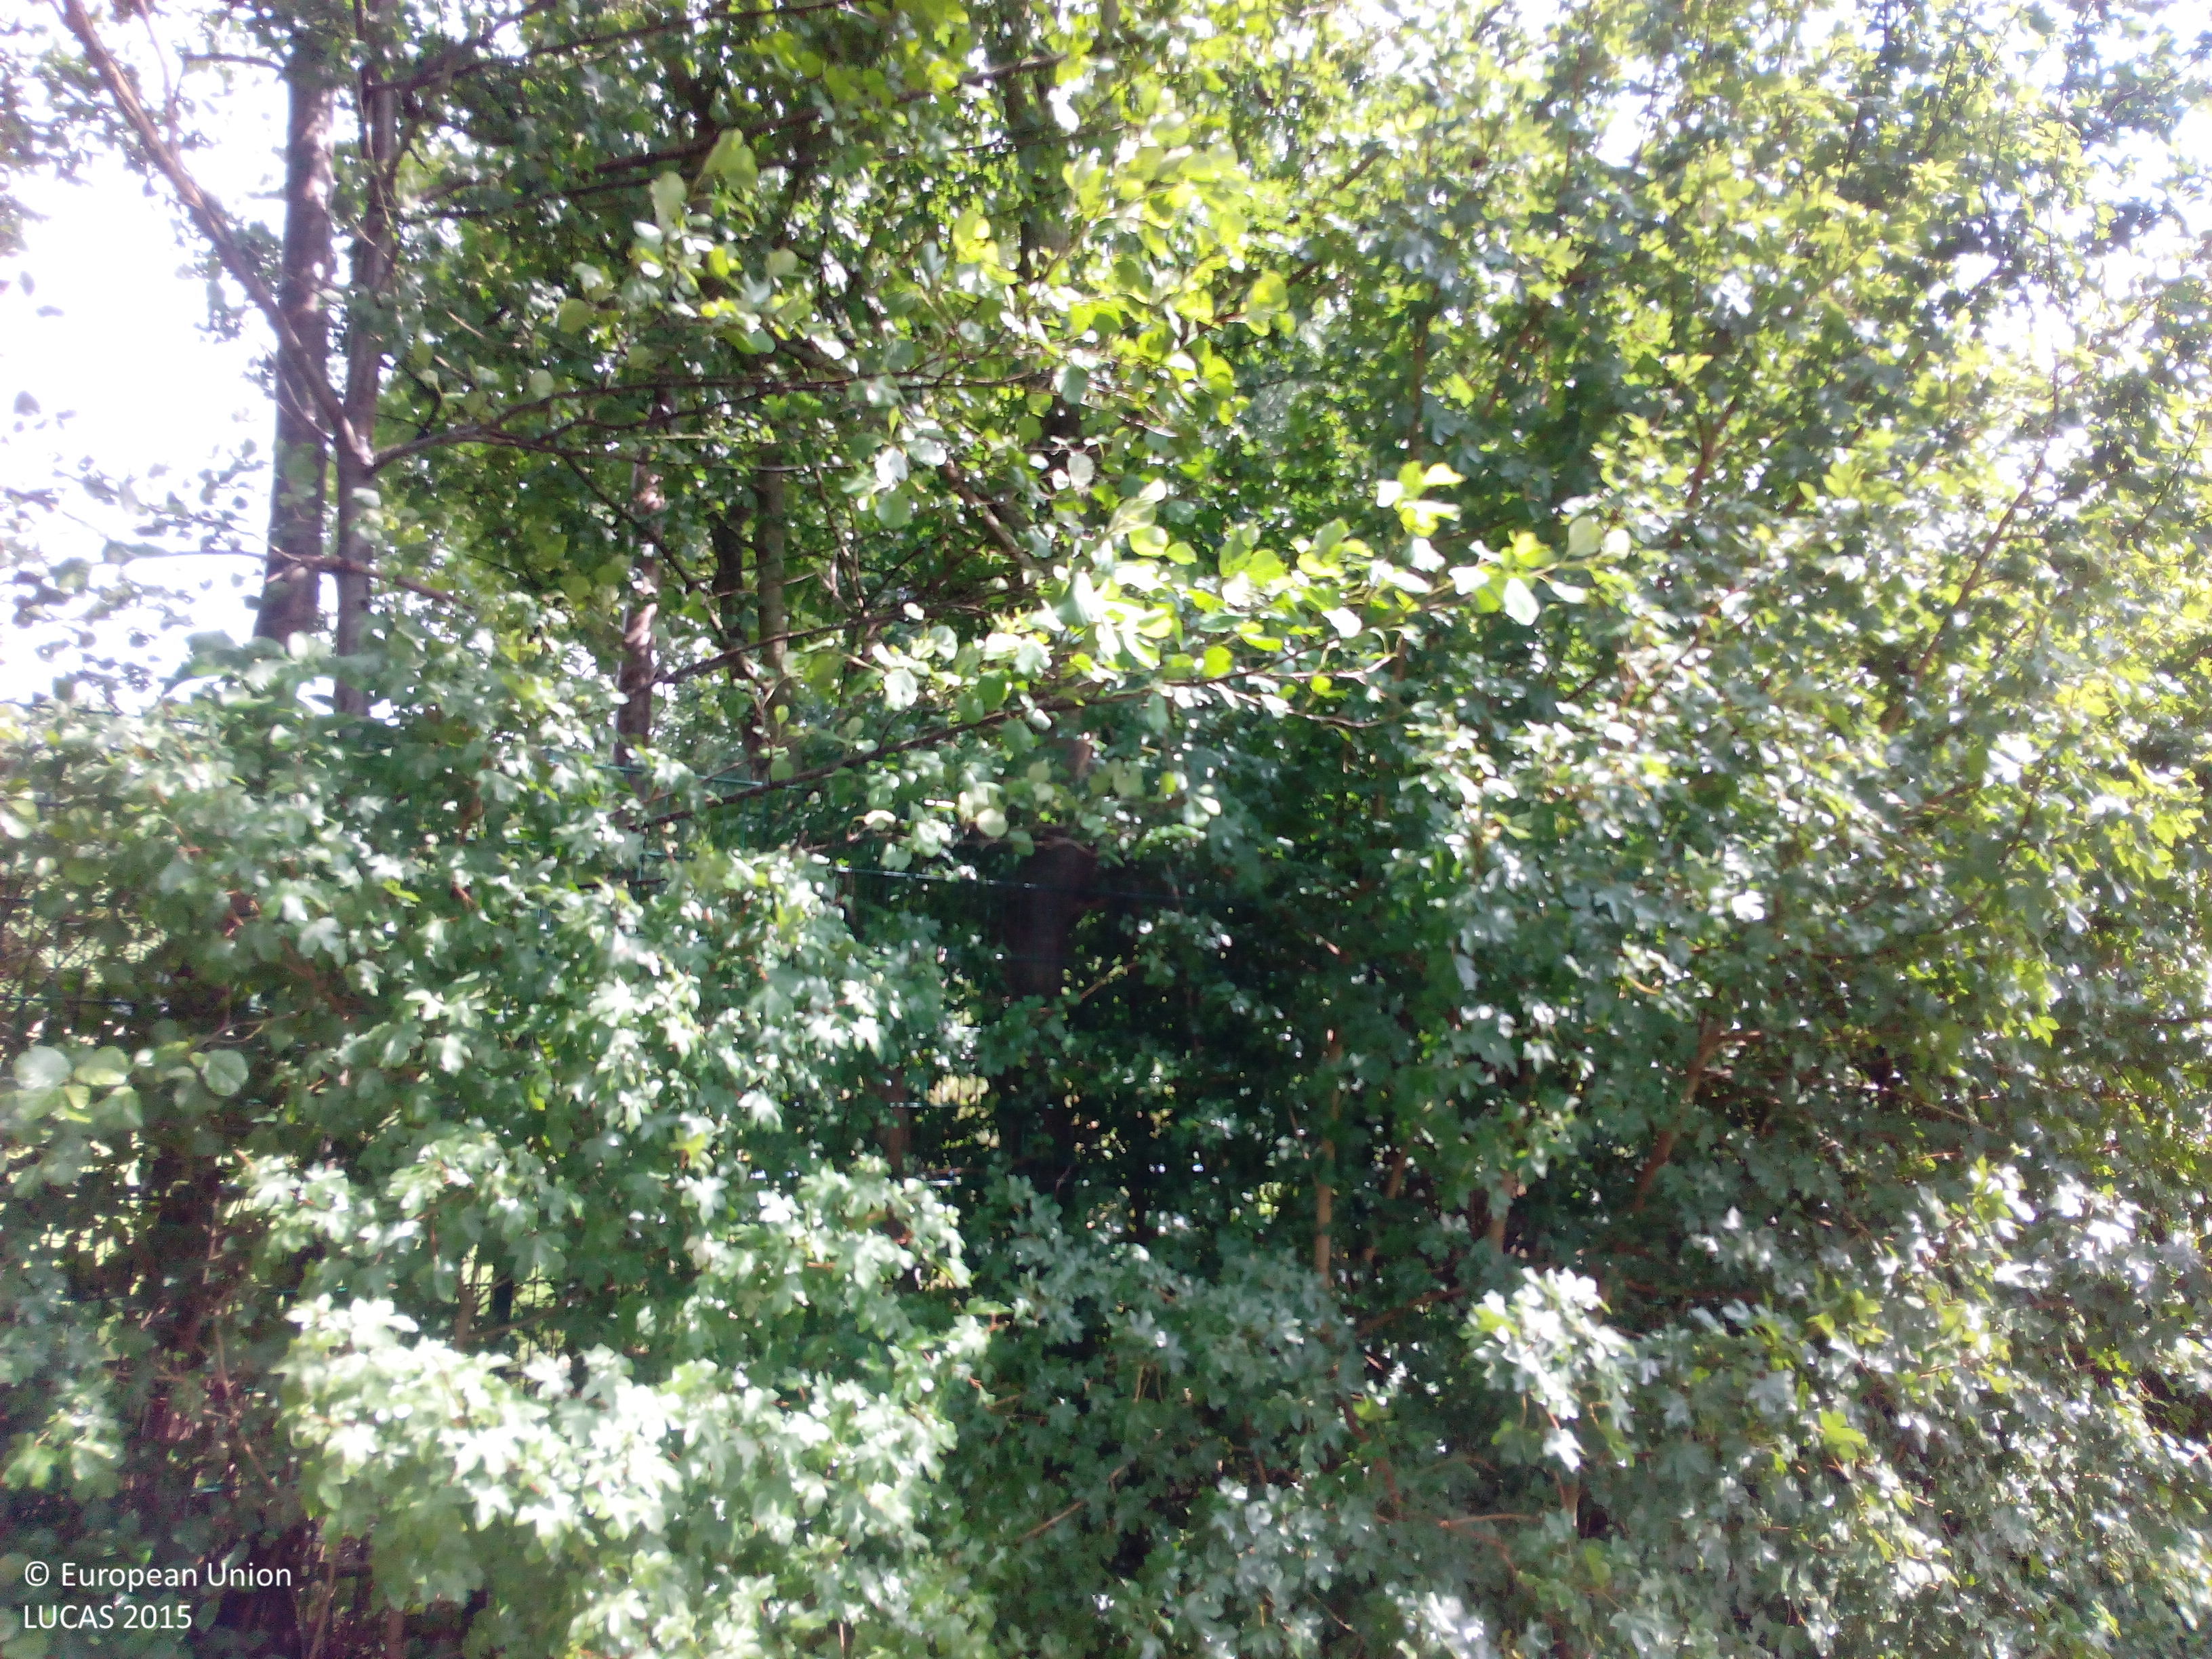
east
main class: Grassland
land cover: Grassland without tree/shrub cover
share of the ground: > 75 %
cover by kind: herbaceous plants 100 %
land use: Agriculture (excluding fallow land and kitchen gardens)
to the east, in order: Grass margins; Ditches and canals; Fences; Lines of trees; Grassland without tree/shrub cover; Fences; Grassland without tree/shrub cover; Fences; Tracks; Broadleaved woodland; Spruce dominated coniferous woodland
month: July
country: DE
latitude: 52.3070
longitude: 8.0205
